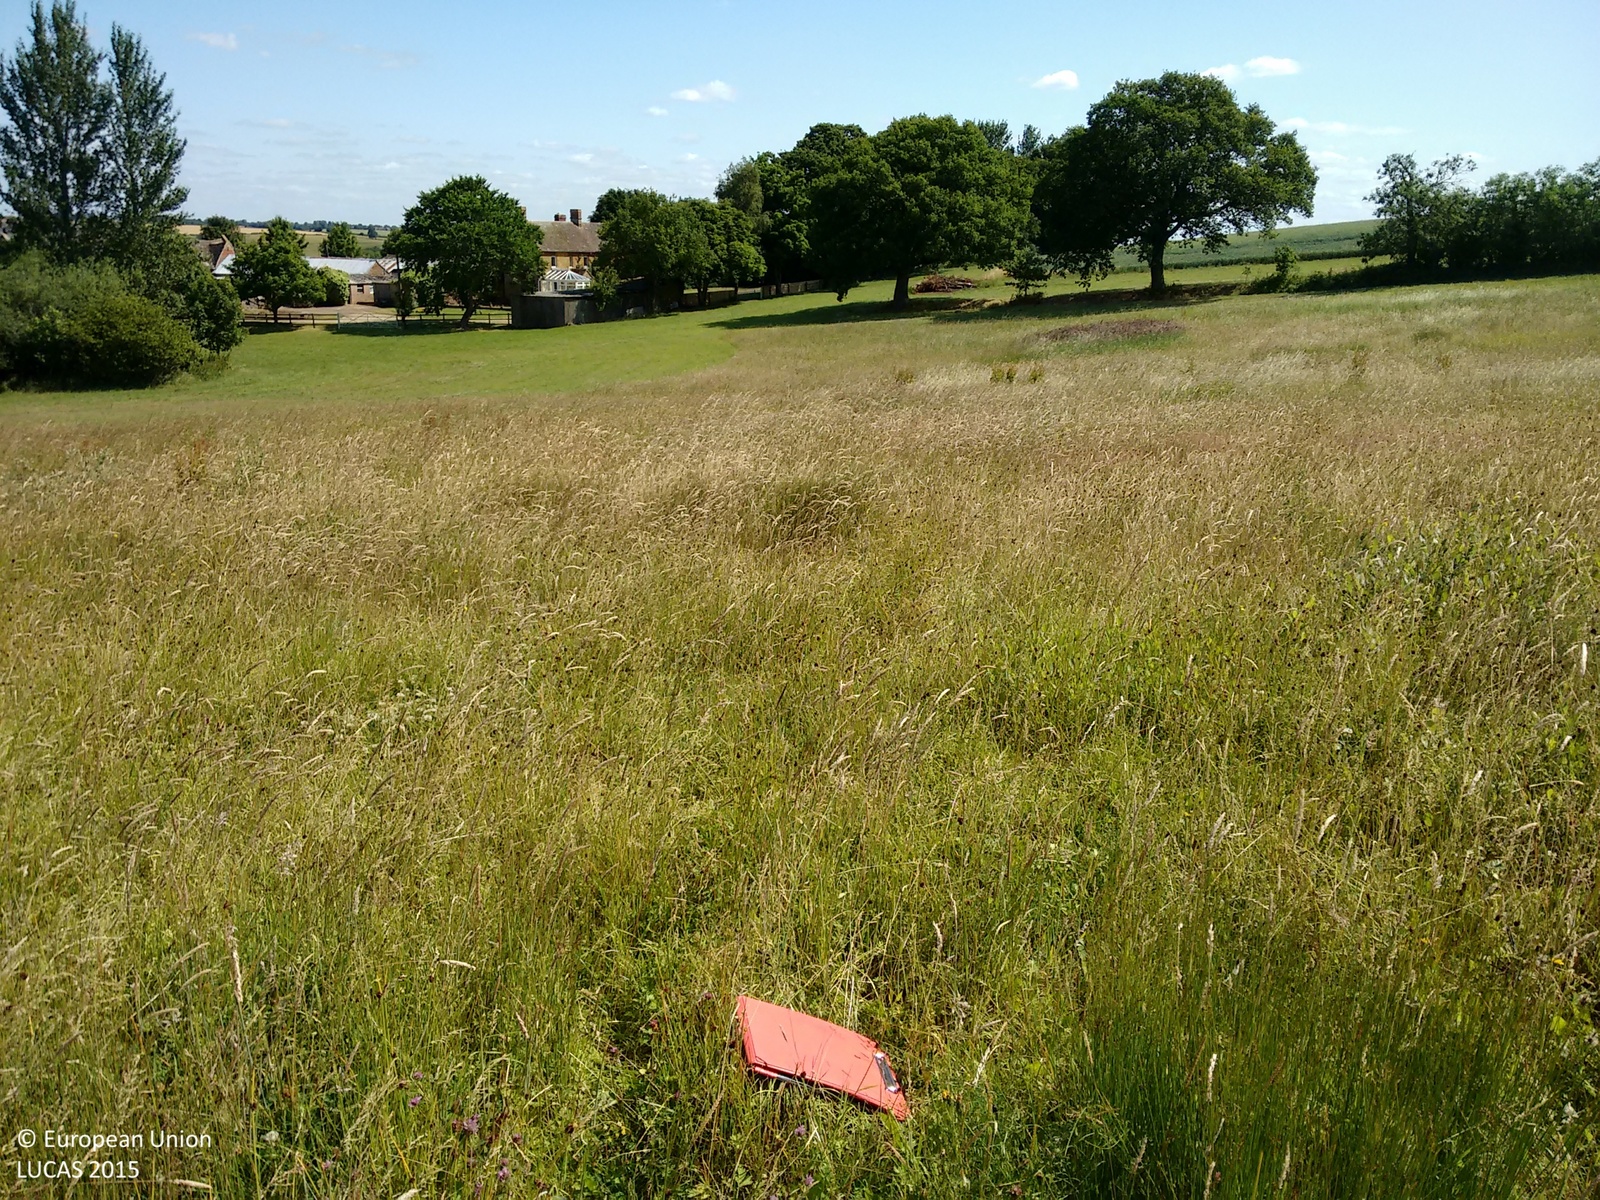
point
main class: Grassland
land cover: Grassland without tree/shrub cover
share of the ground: > 75 %
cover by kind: herbaceous plants 100 %
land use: Agriculture (excluding fallow land and kitchen gardens)
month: July
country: GB
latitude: 51.9576
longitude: -1.3561
